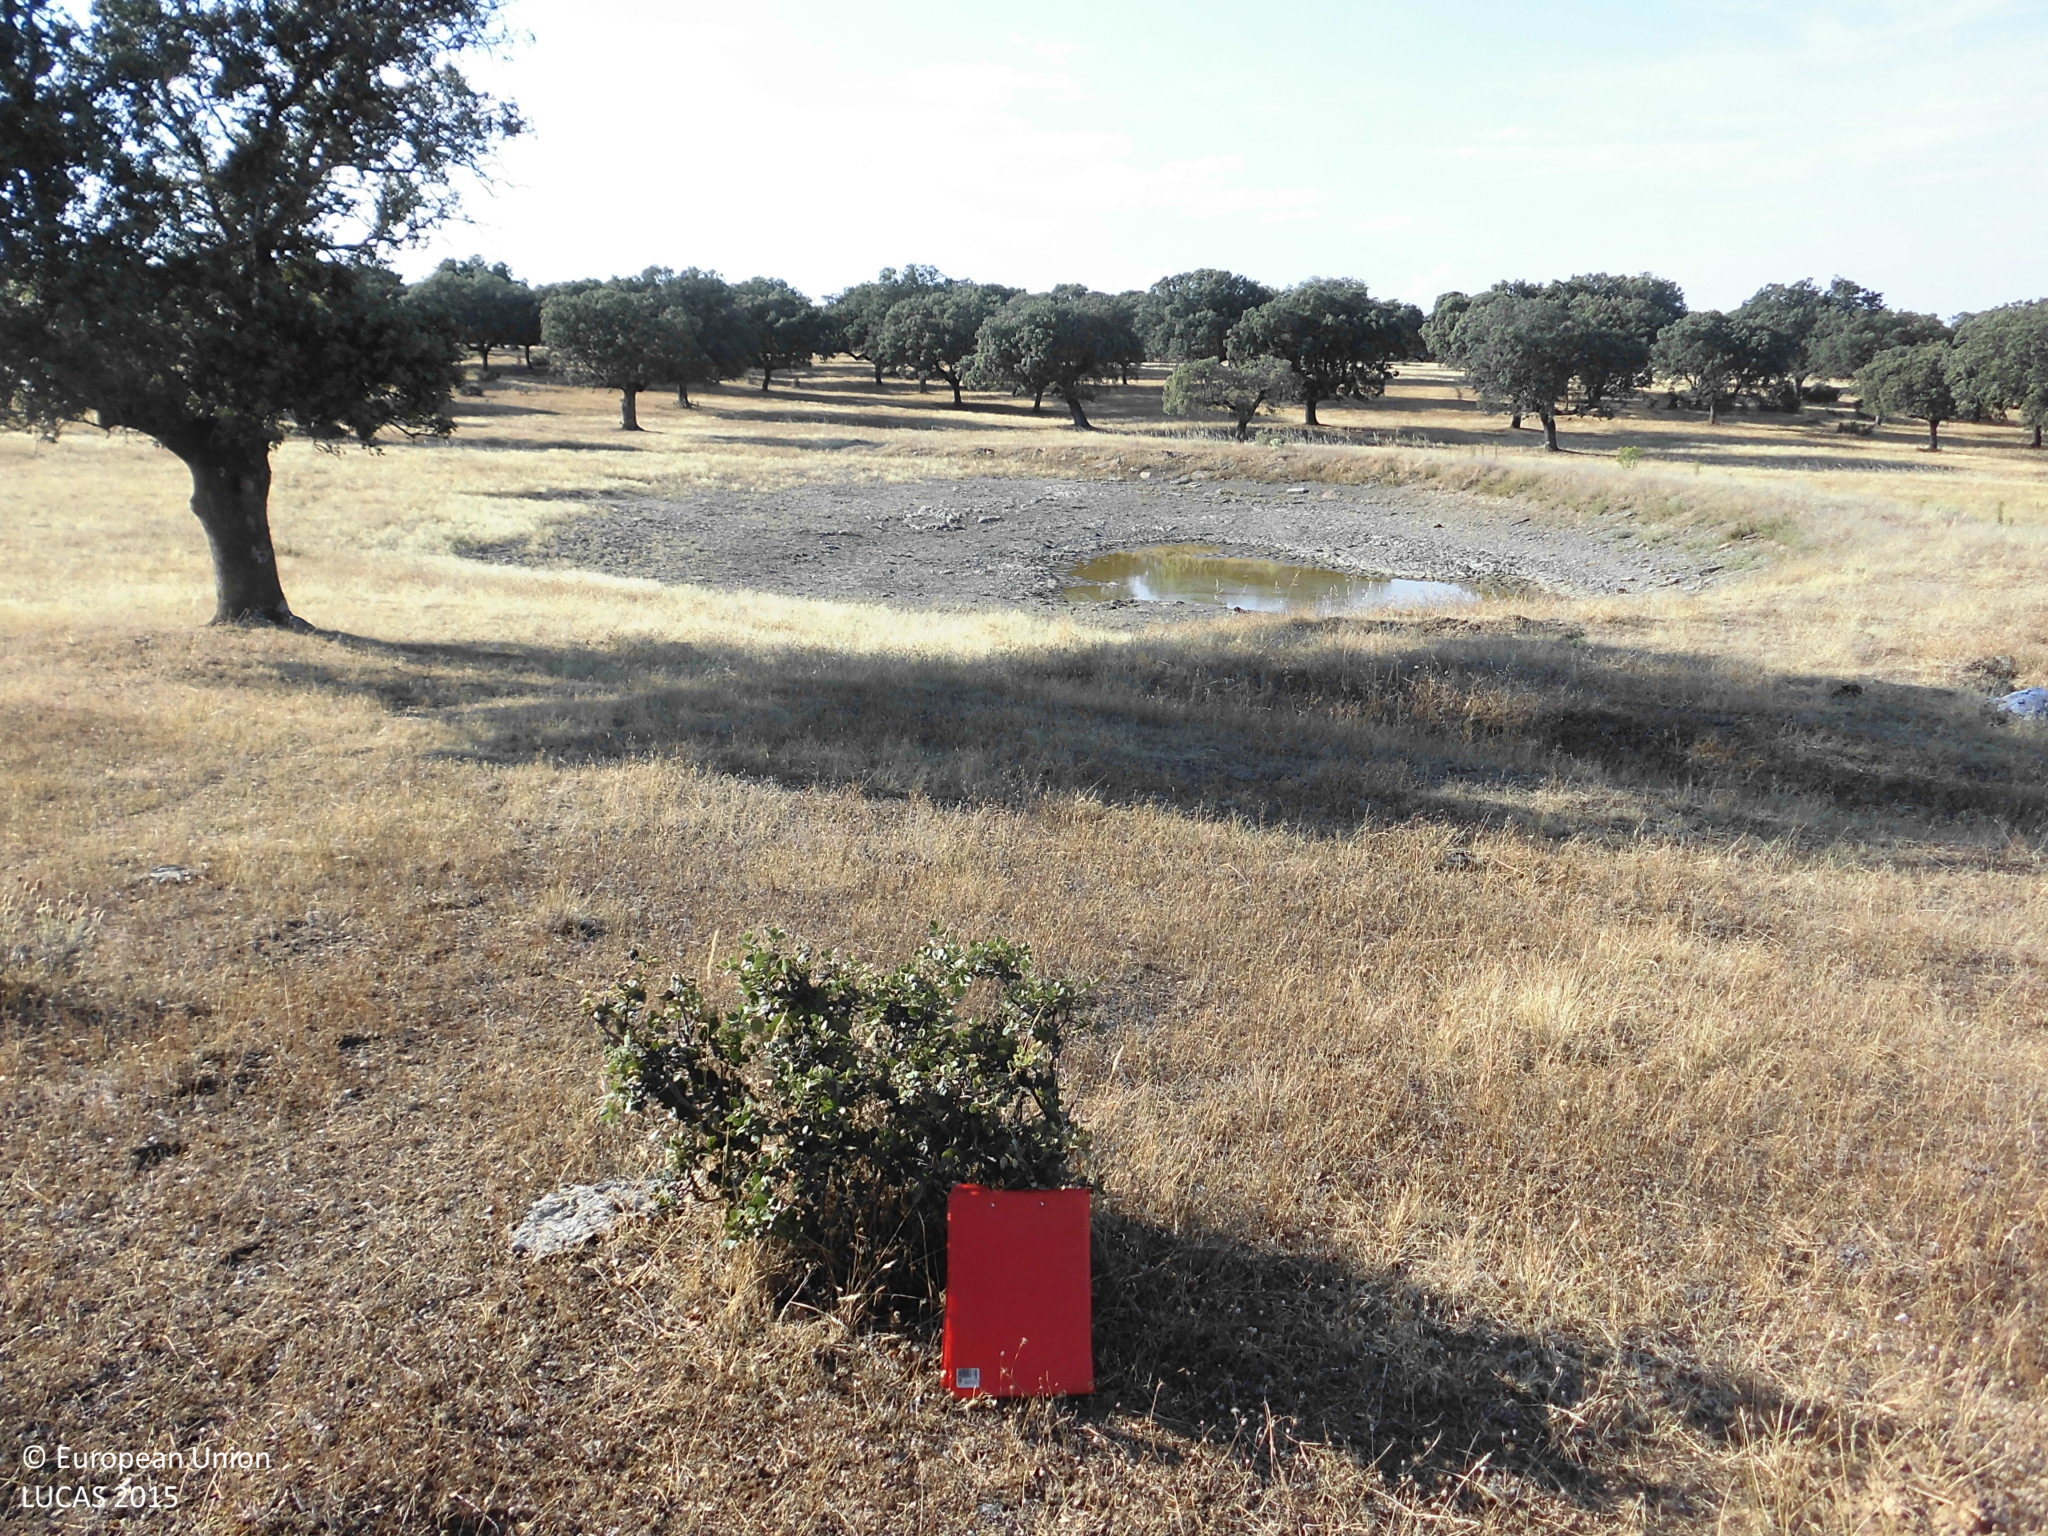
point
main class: Woodland
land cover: Broadleaved woodland
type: broadleaved evergreen forest
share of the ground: 25 - 50 %
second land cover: Grassland without tree/shrub cover
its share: > 75 %
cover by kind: herbaceous plants 75 %, broadleaved forest trees 25 %
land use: Forestry
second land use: Agriculture (excluding fallow land and kitchen gardens)
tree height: > 5 m
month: June
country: ES
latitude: 39.9161
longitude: -6.1332
